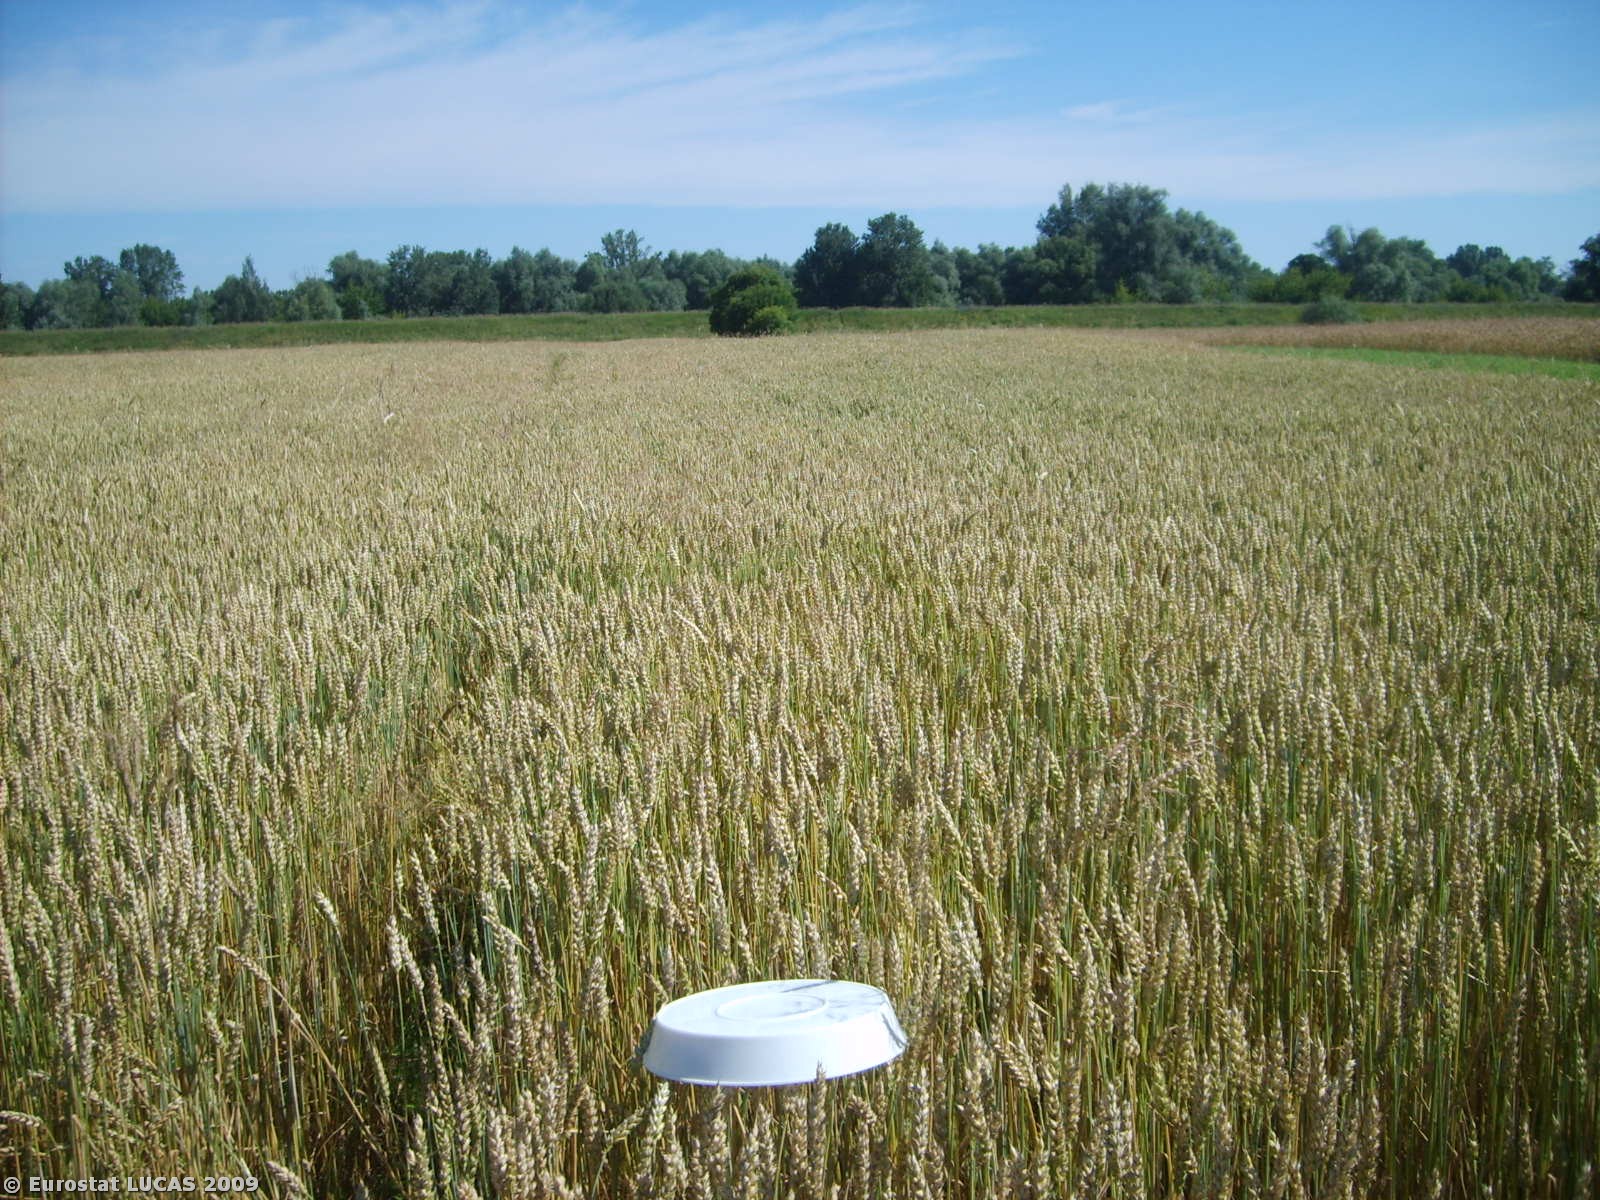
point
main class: Cropland
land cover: Common wheat
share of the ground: > 75 %
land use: Agriculture (excluding fallow land and kitchen gardens)
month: July
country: PL
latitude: 52.3954
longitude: 20.7545
